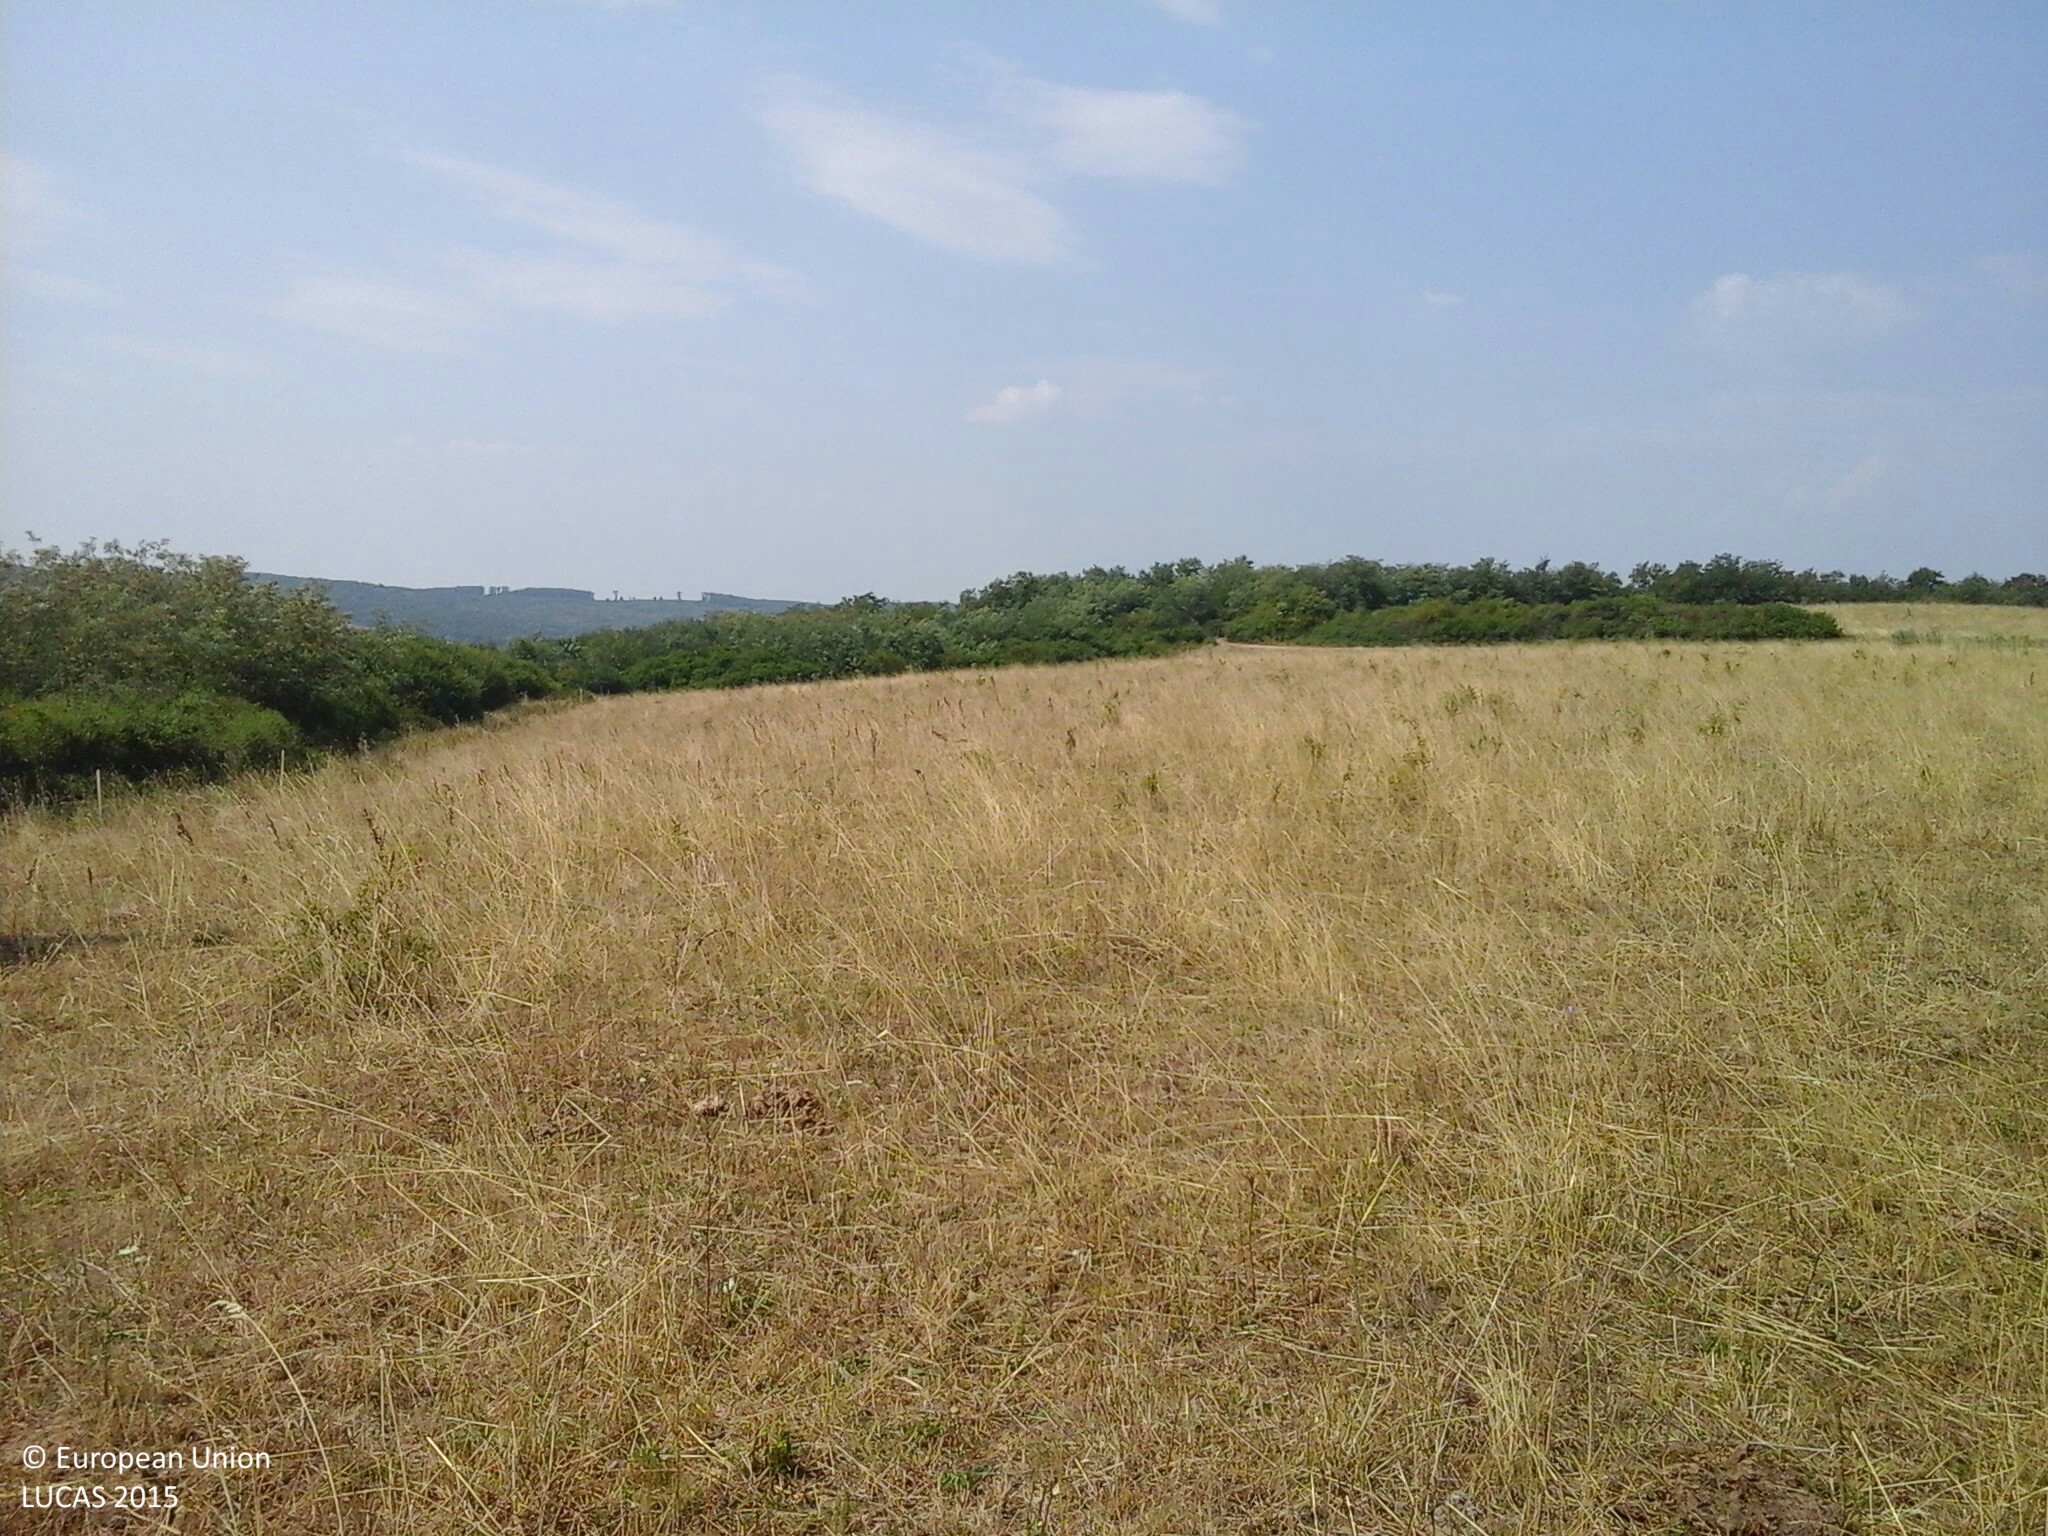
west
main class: Grassland
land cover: Grassland without tree/shrub cover
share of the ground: > 75 %
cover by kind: herbaceous plants 100 %
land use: Agriculture (excluding fallow land and kitchen gardens)
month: August
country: HU
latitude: 48.4071
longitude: 20.5314
